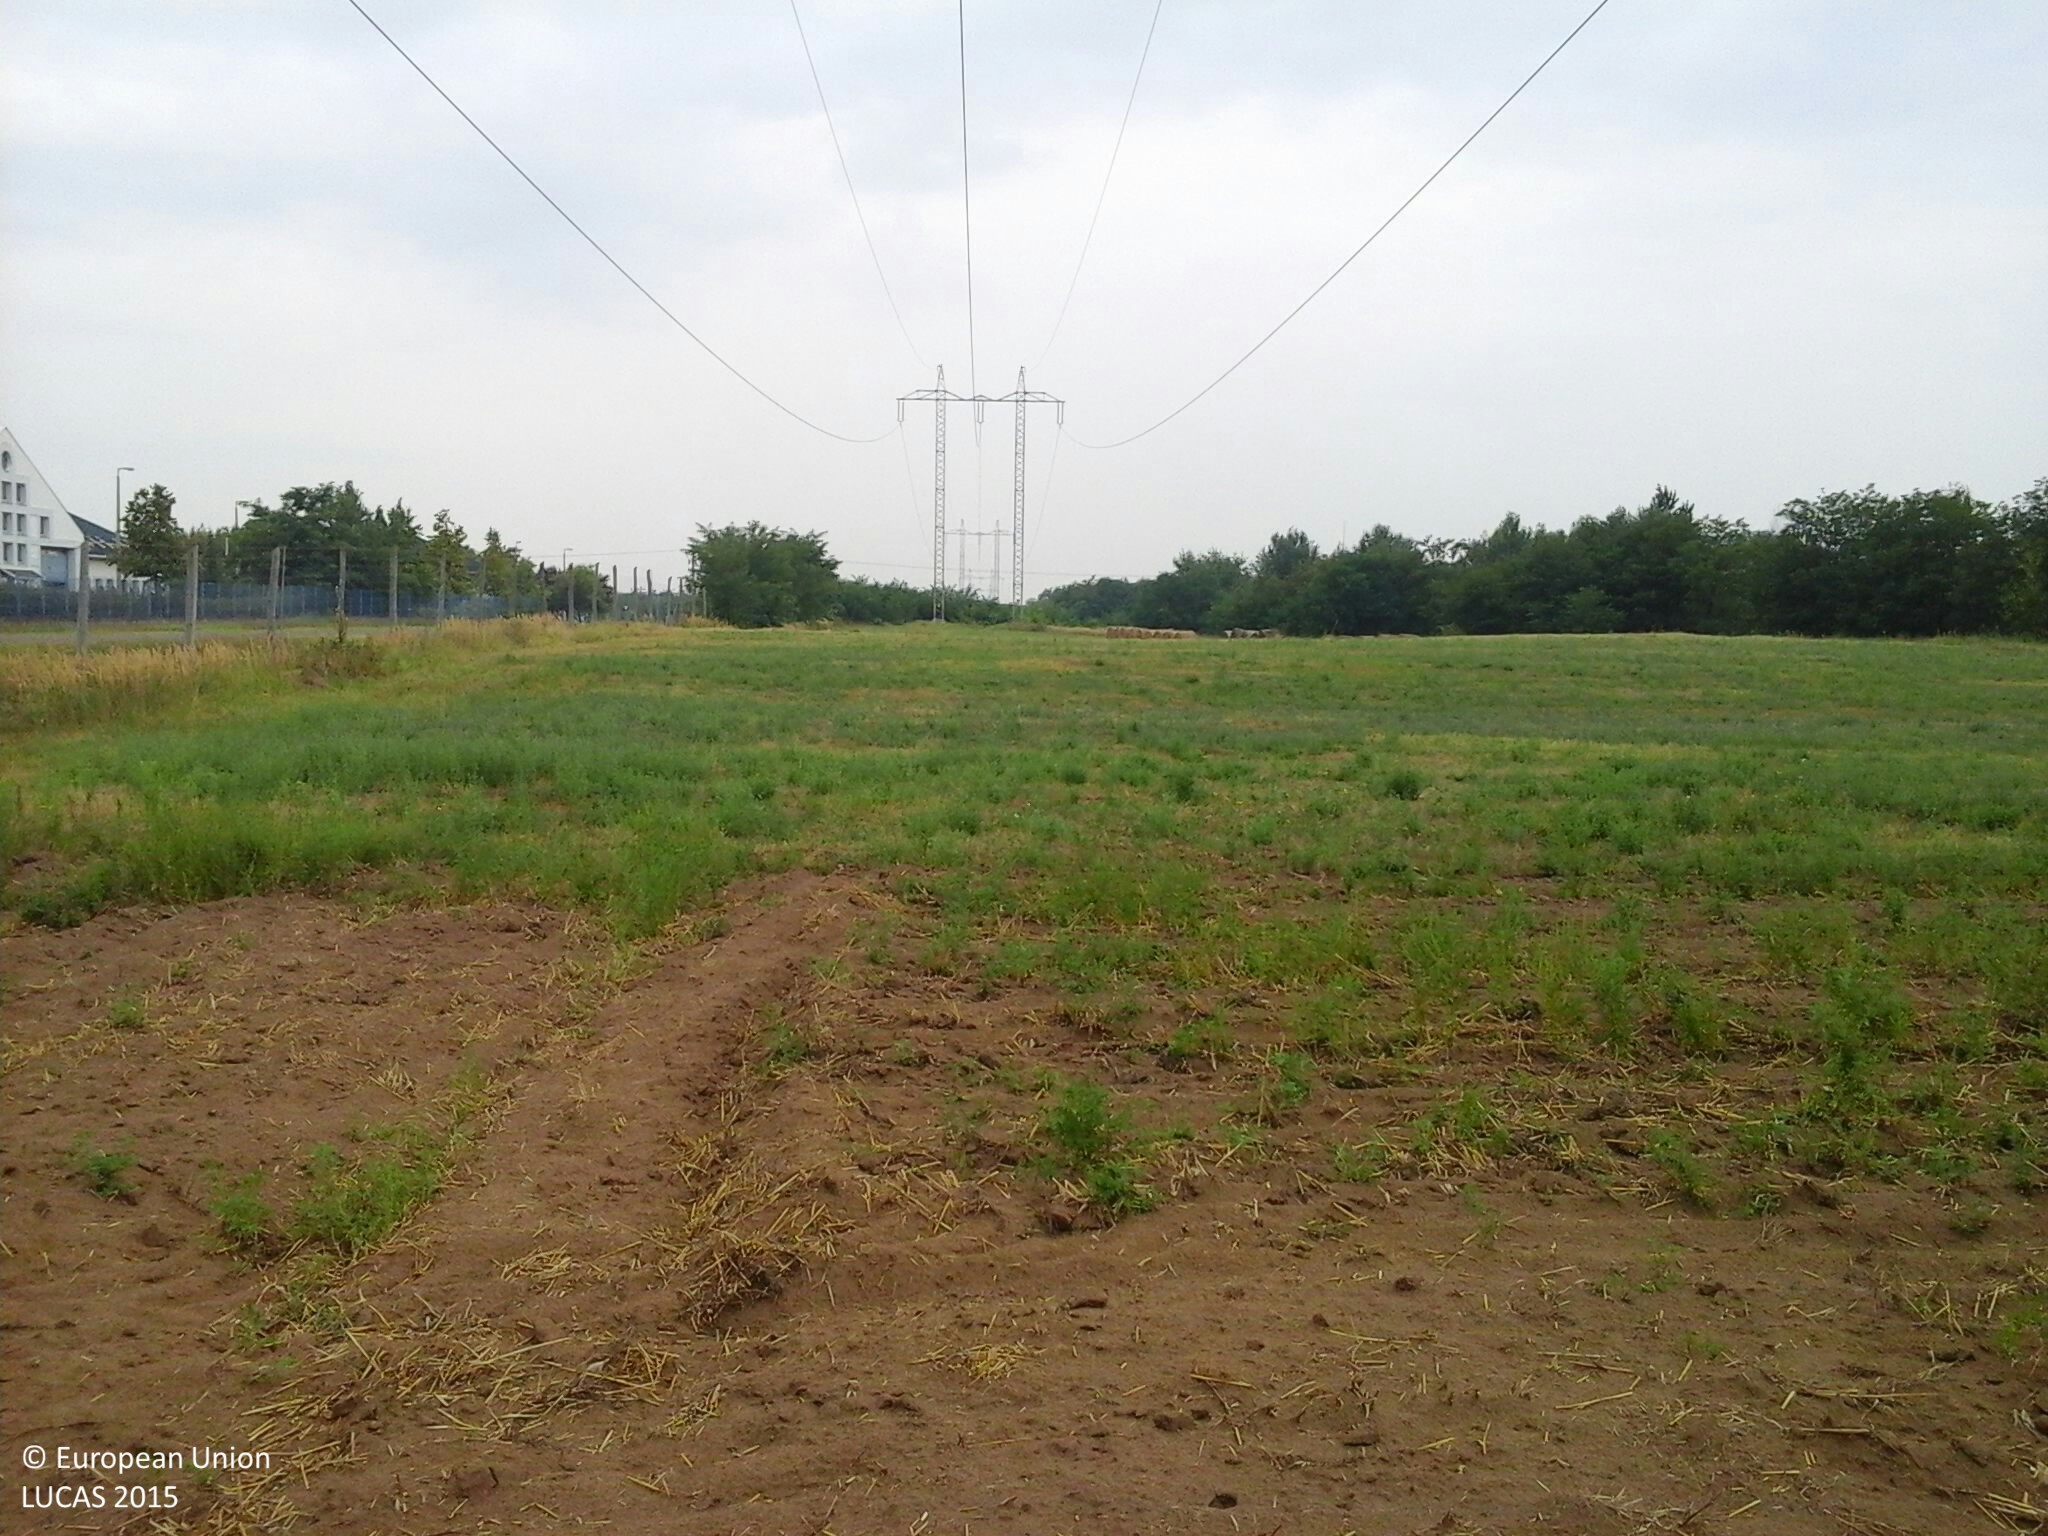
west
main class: Cropland
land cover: Common wheat
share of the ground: 10 - 25 %
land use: Agriculture (excluding fallow land and kitchen gardens)
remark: Harvested field
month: August
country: HU
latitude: 47.7234
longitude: 20.2818
